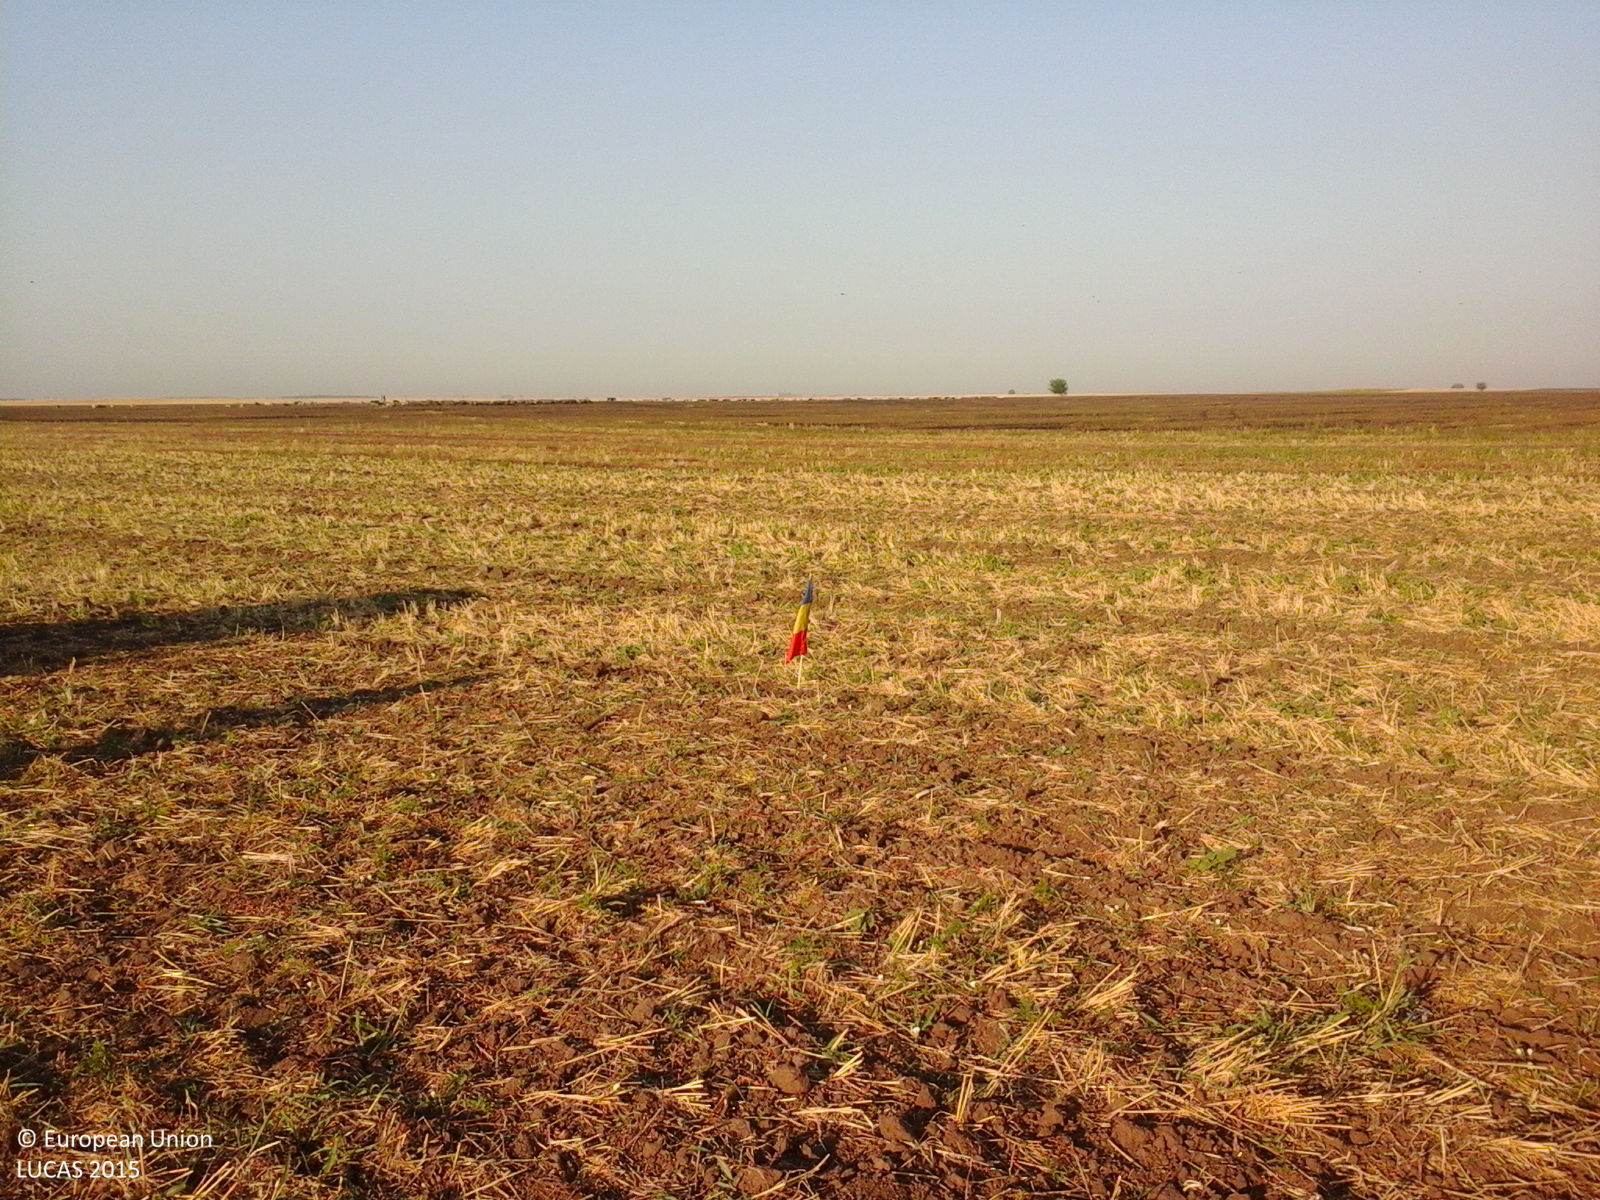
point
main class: Cropland
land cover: Common wheat
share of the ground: 50 - 75 %
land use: Agriculture (excluding fallow land and kitchen gardens)
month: August
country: RO
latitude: 44.0783
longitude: 23.2702
